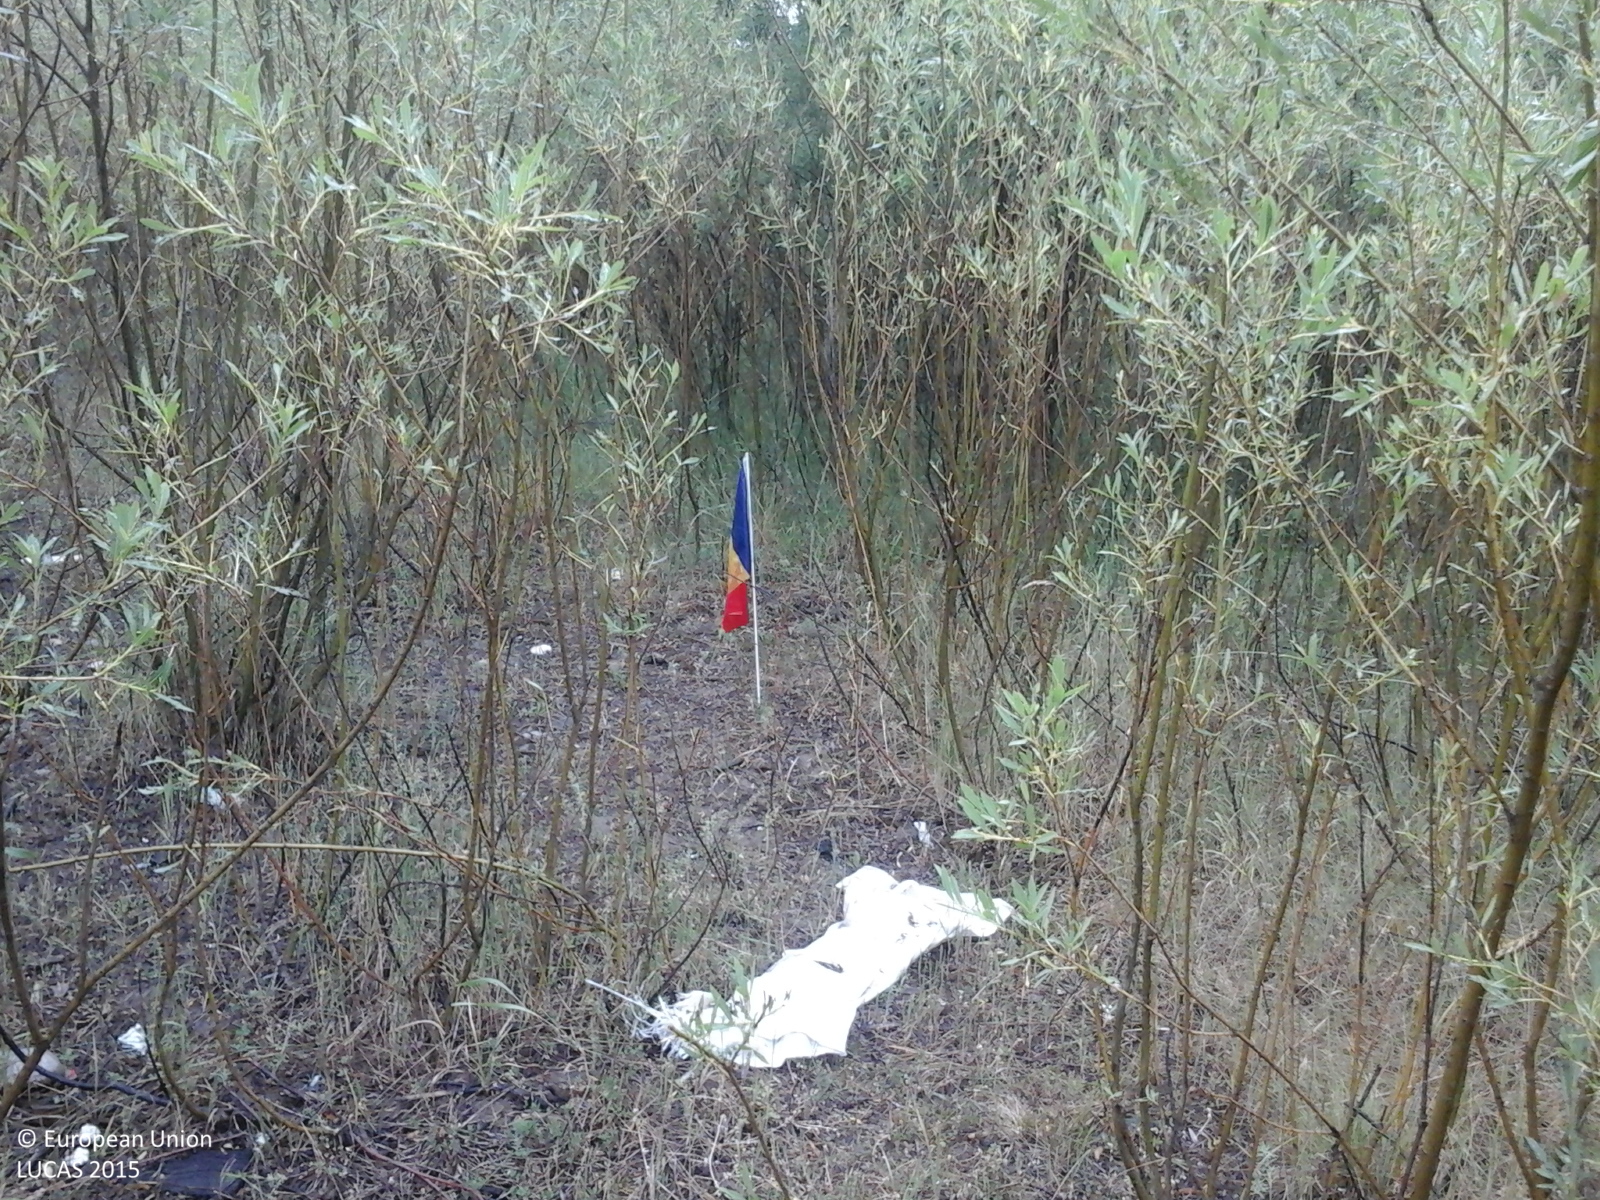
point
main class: Shrubland
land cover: Shrubland without tree cover
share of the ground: 50 - 75 %
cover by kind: shrubs 75 %, herbaceous plants 25 %
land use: Semi-natural and natural areas not in use
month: June
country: RO
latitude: 47.3542
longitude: 26.3815
